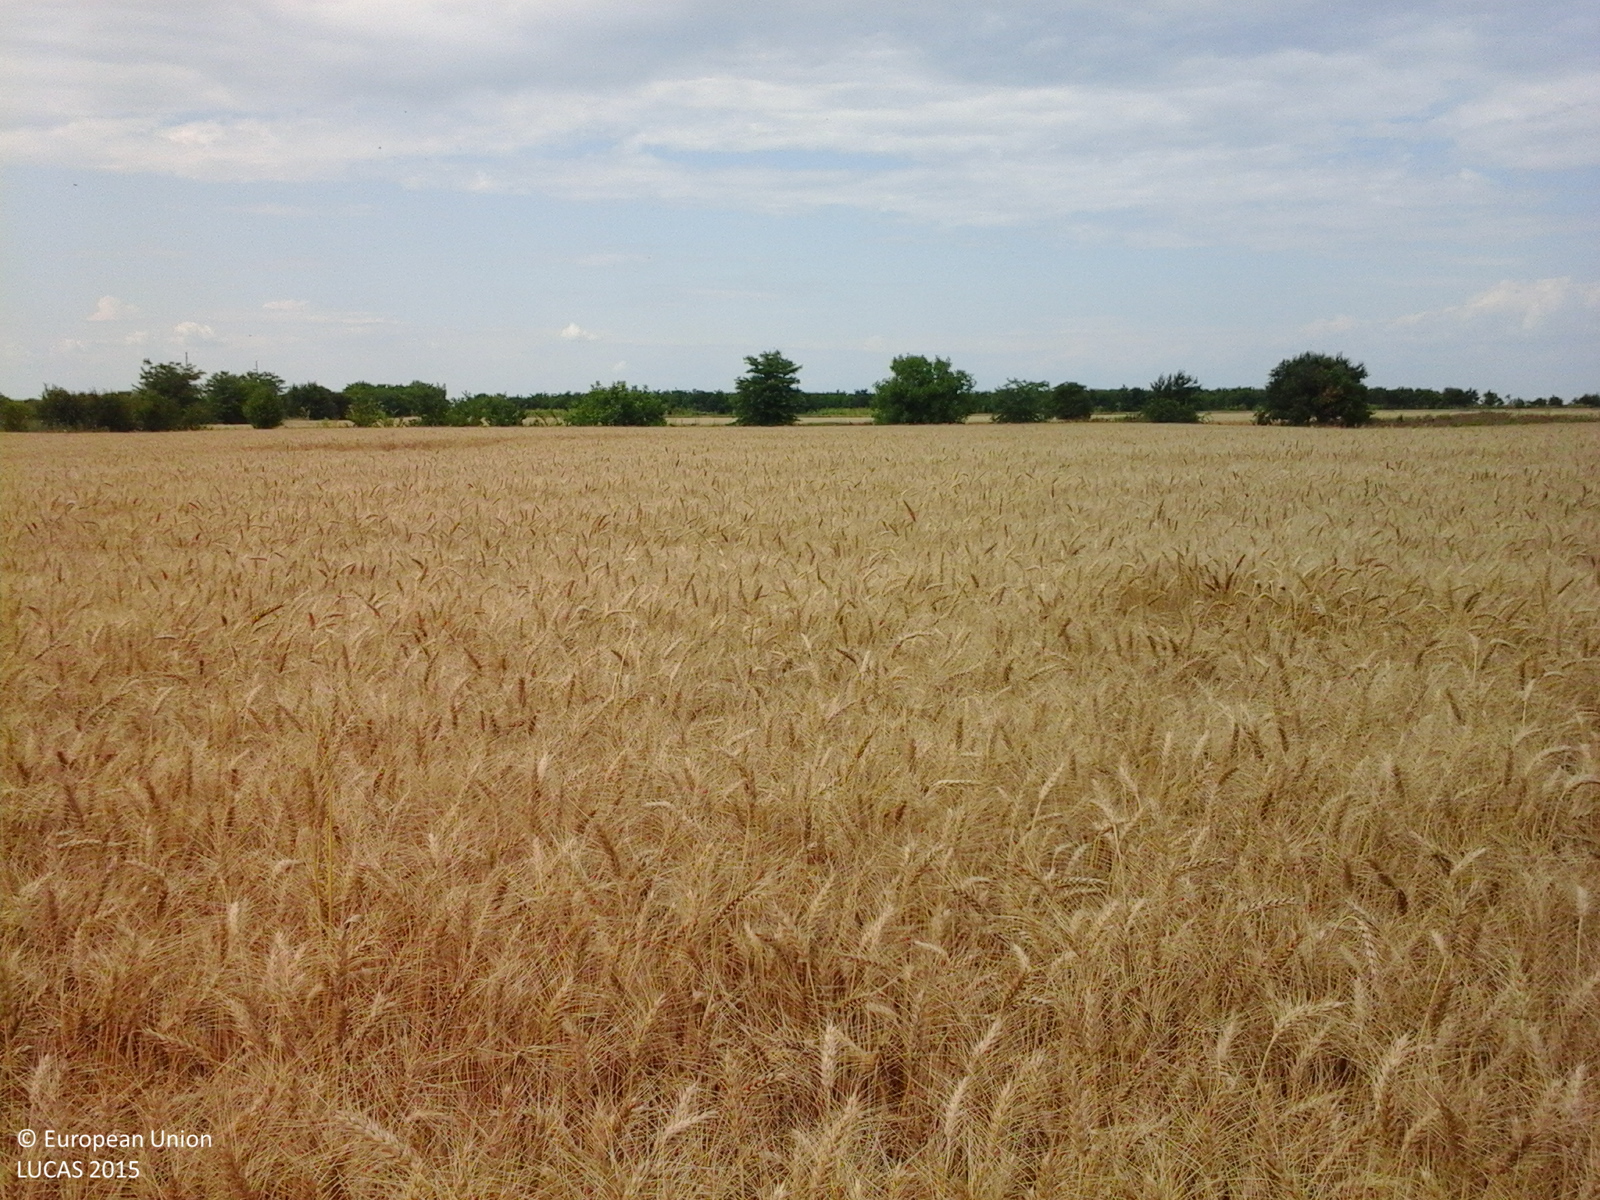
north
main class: Cropland
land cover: Common wheat
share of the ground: > 75 %
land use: Agriculture (excluding fallow land and kitchen gardens)
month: June
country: RO
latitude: 44.5651
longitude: 26.1356
